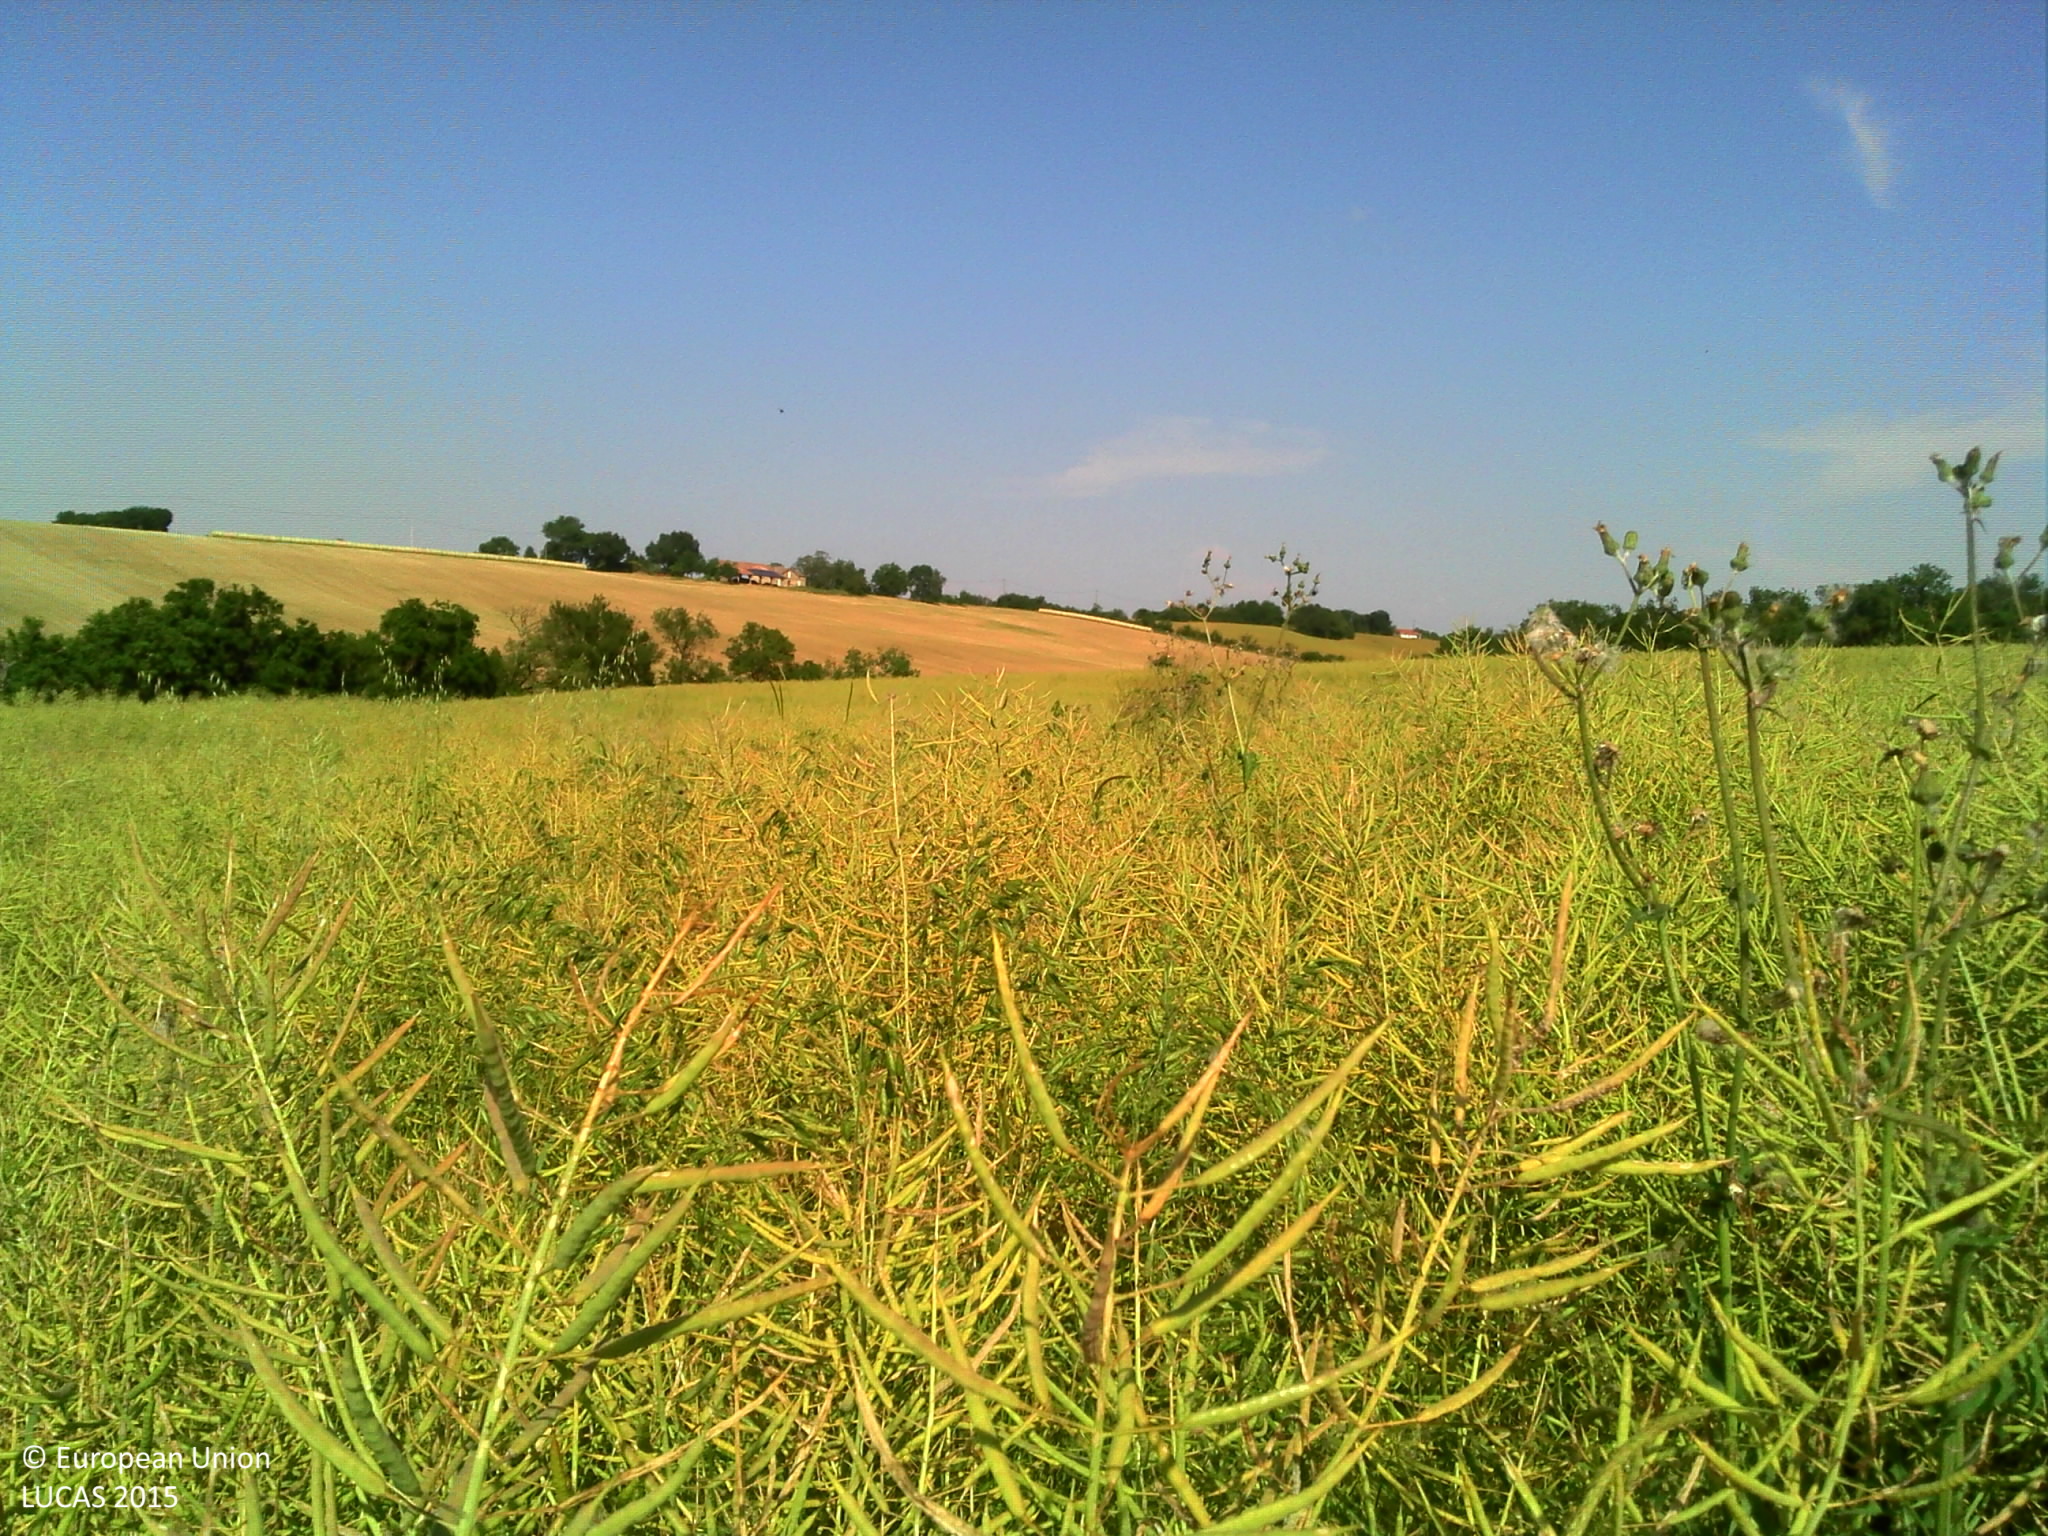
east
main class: Cropland
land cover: Rape and turnip rape
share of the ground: > 75 %
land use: Agriculture (excluding fallow land and kitchen gardens)
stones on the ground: < 10 %
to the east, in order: Rape and turnip rape
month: June
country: FR
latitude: 43.6832
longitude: 0.7568
